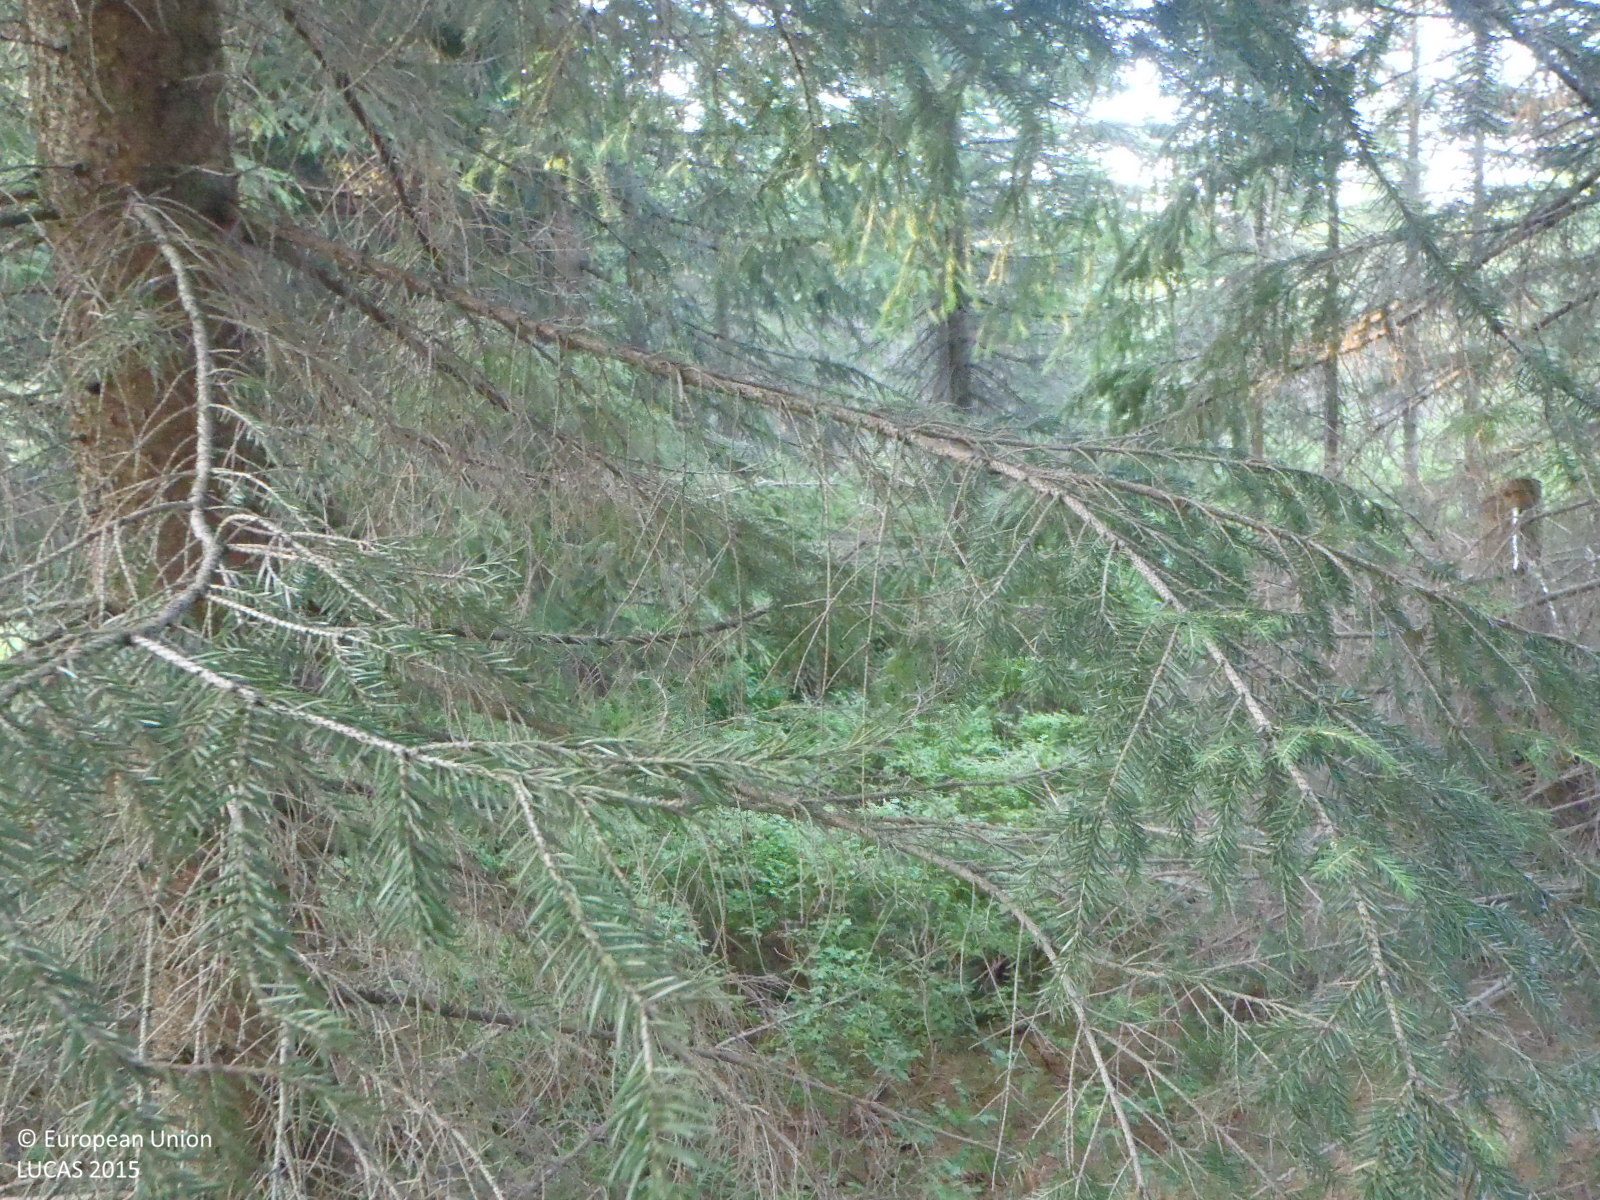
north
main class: Woodland
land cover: Spruce dominated coniferous woodland
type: hemiboreal forest and nemoral coniferous forest and mixed broadleaved-coniferous forest
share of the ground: > 75 %
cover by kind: coniferous forest trees 80 %, shrubs 10 %, herbaceous plants 10 %
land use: Forestry
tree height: > 5 m
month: August
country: CZ
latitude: 50.8551
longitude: 15.2738
